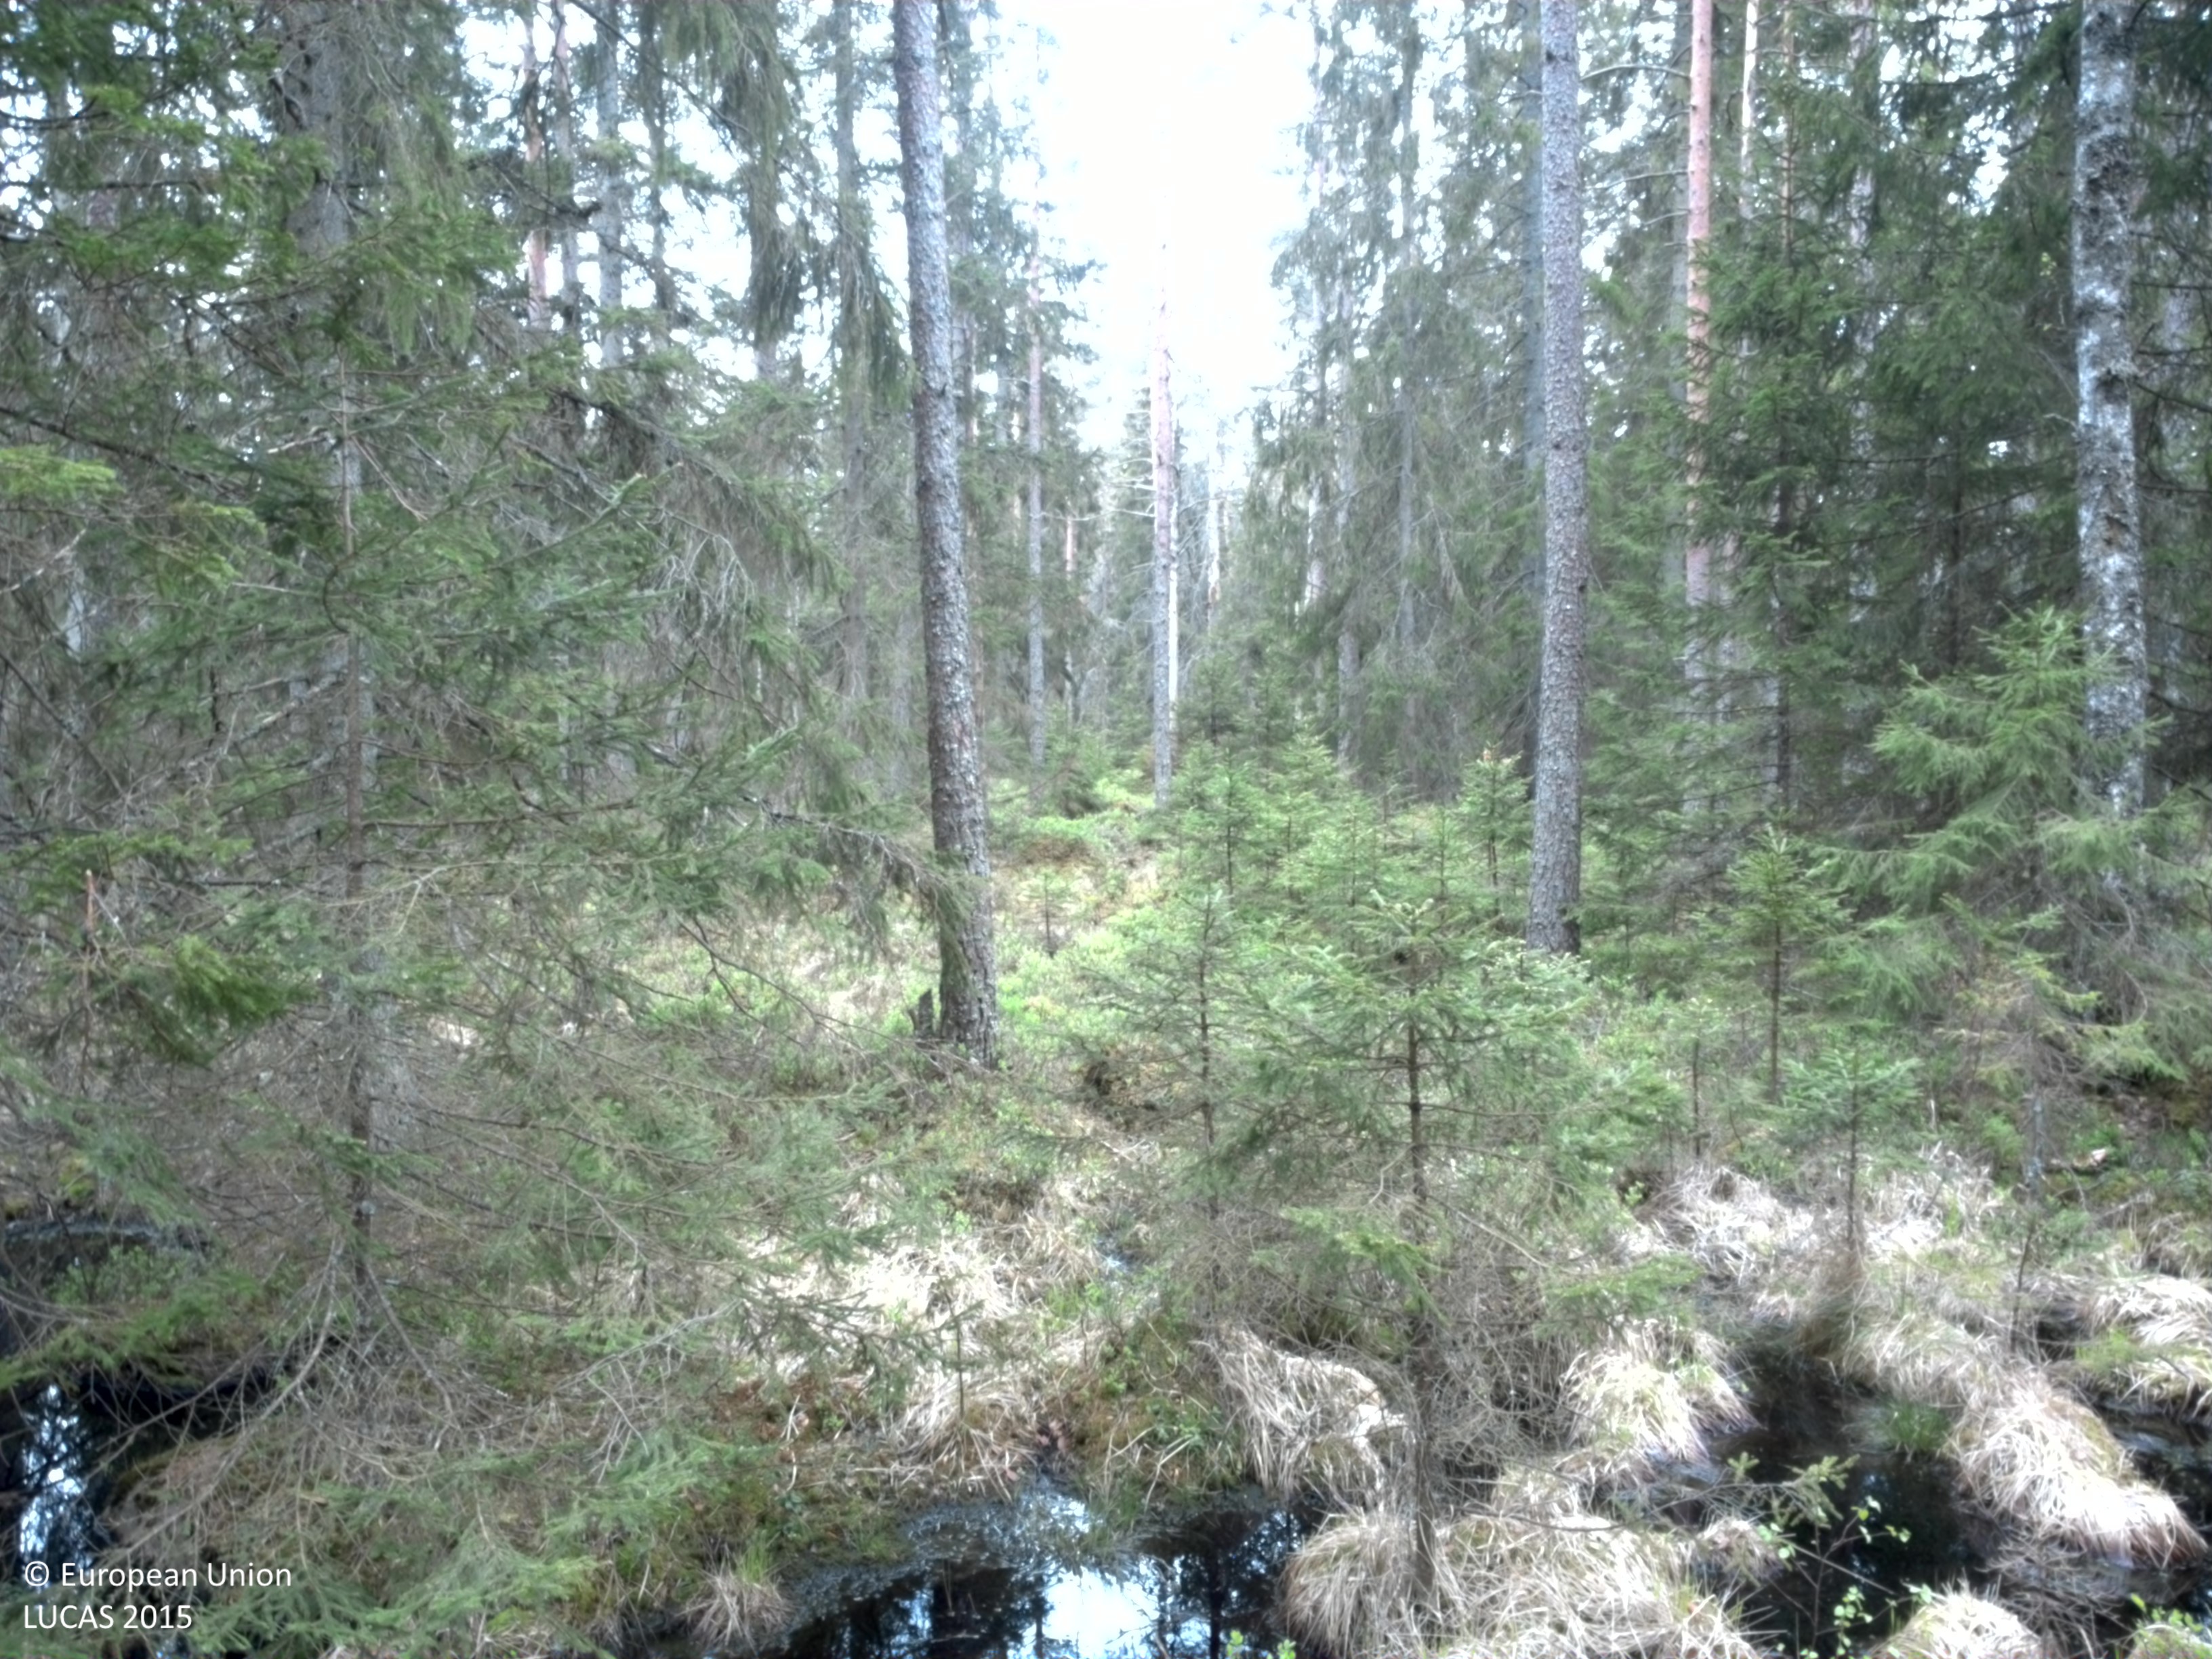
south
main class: Woodland
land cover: Pine dominated coniferous woodland
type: boreal forest
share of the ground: 50 - 75 %
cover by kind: coniferous forest trees 70 %, shrubs 15 %, lichens and mosses 15 %
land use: Forestry
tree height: > 5 m
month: May
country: SE
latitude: 56.8766
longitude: 15.1663
